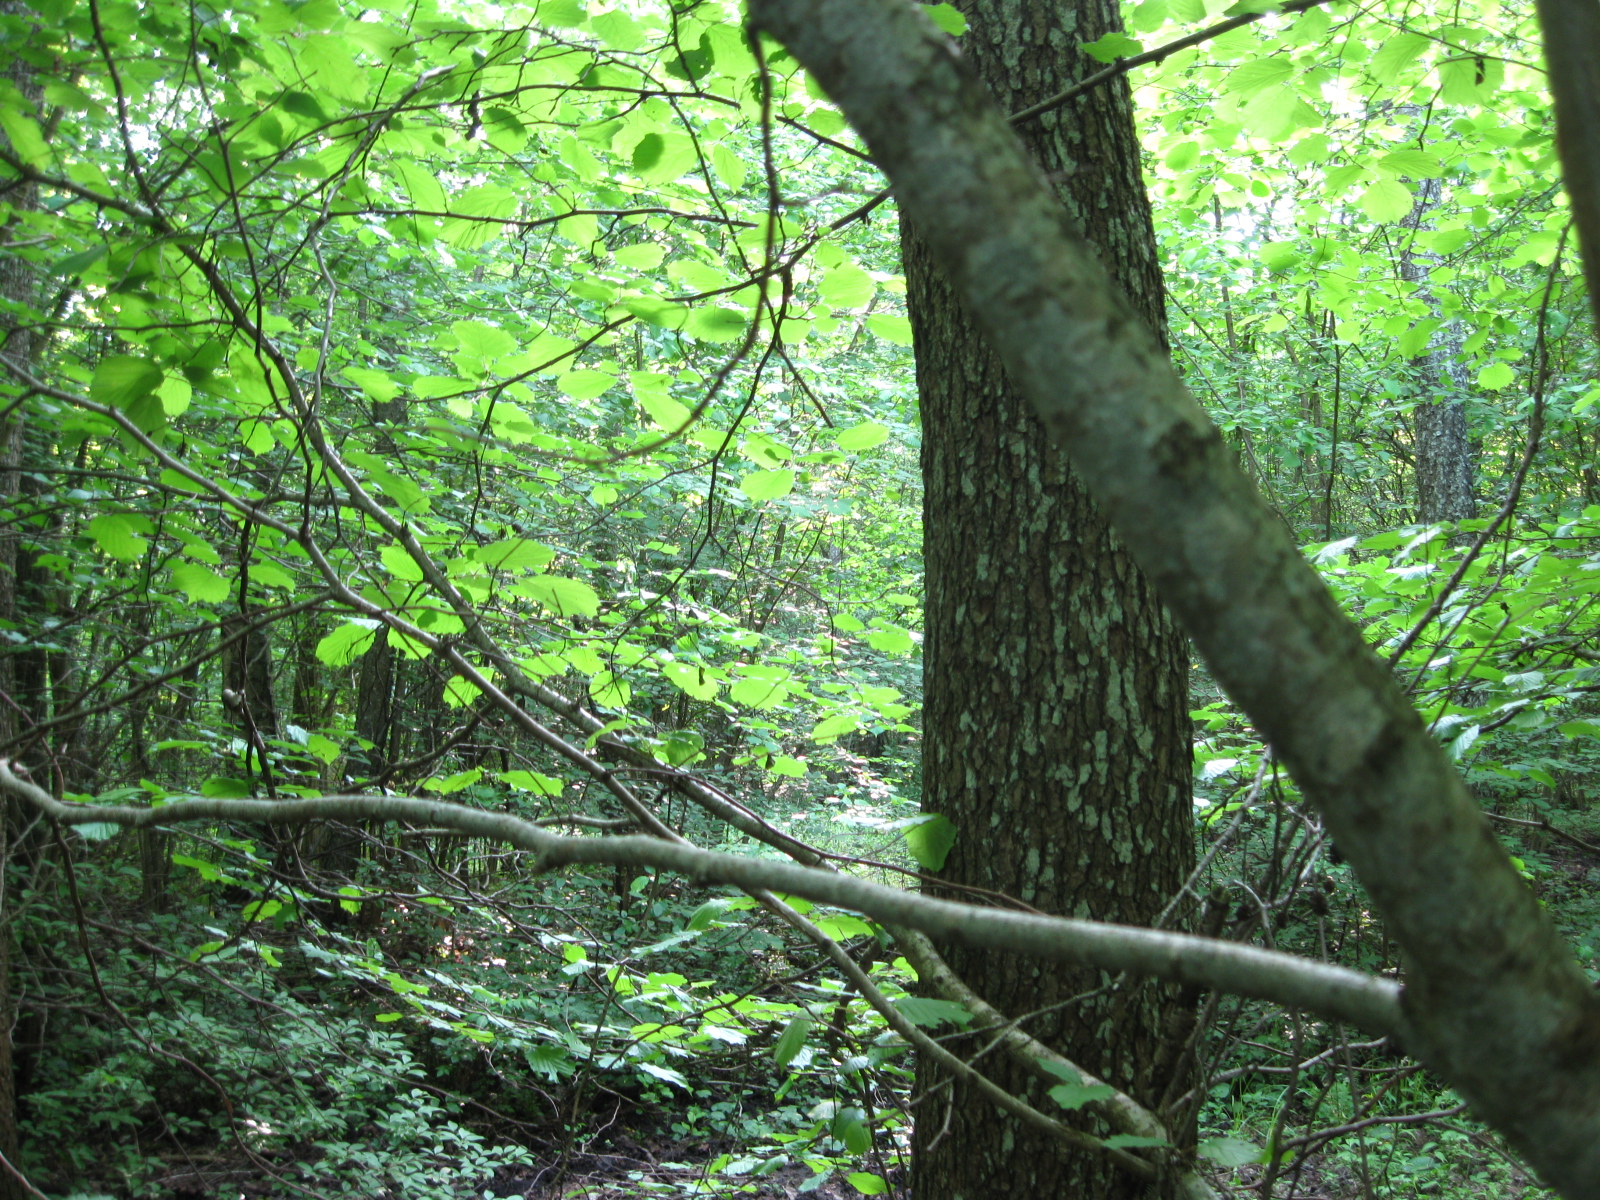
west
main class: Woodland
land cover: Broadleaved woodland
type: non-riverine alder, birch or aspen forest
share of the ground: > 75 %
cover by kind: broadleaved forest trees 90 %, shrubs 5 %, herbaceous plants 5 %
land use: Forestry
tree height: > 5 m
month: June
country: LT
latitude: 55.7904
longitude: 24.0765
